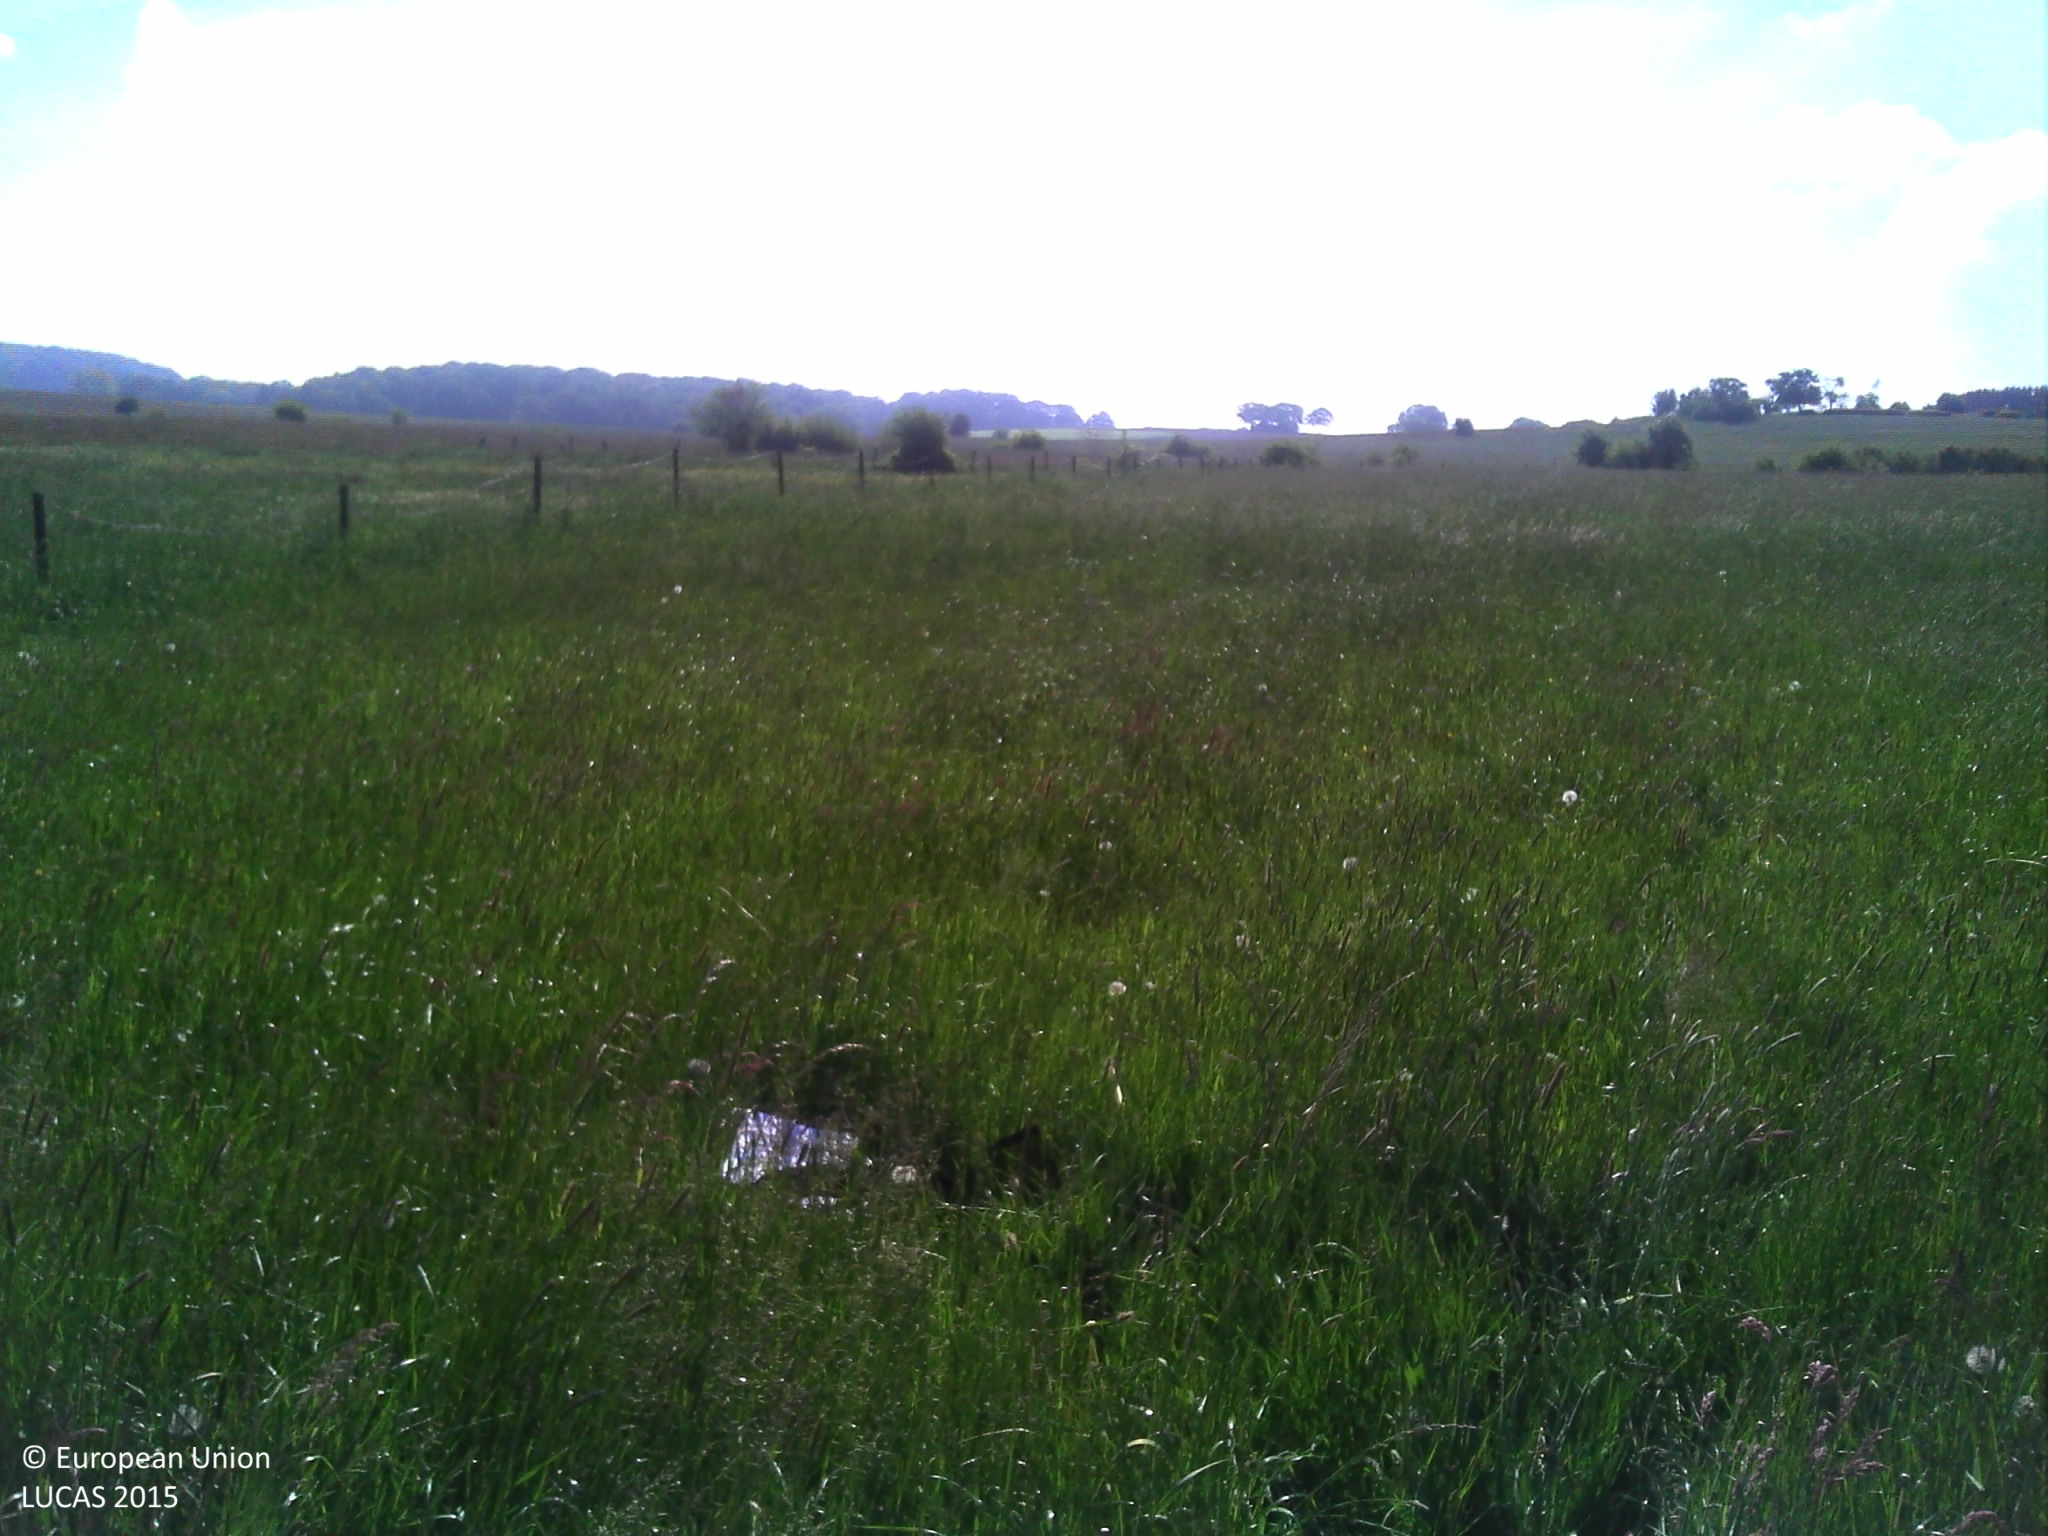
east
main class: Grassland
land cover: Grassland without tree/shrub cover
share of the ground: > 75 %
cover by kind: herbaceous plants 100 %
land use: Agriculture (excluding fallow land and kitchen gardens)
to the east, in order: Grassland without tree/shrub cover; Fences; Grassland without tree/shrub cover; Ditches and canals; Grassland without tree/shrub cover
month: May
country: LU
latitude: 49.6194
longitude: 6.2761
